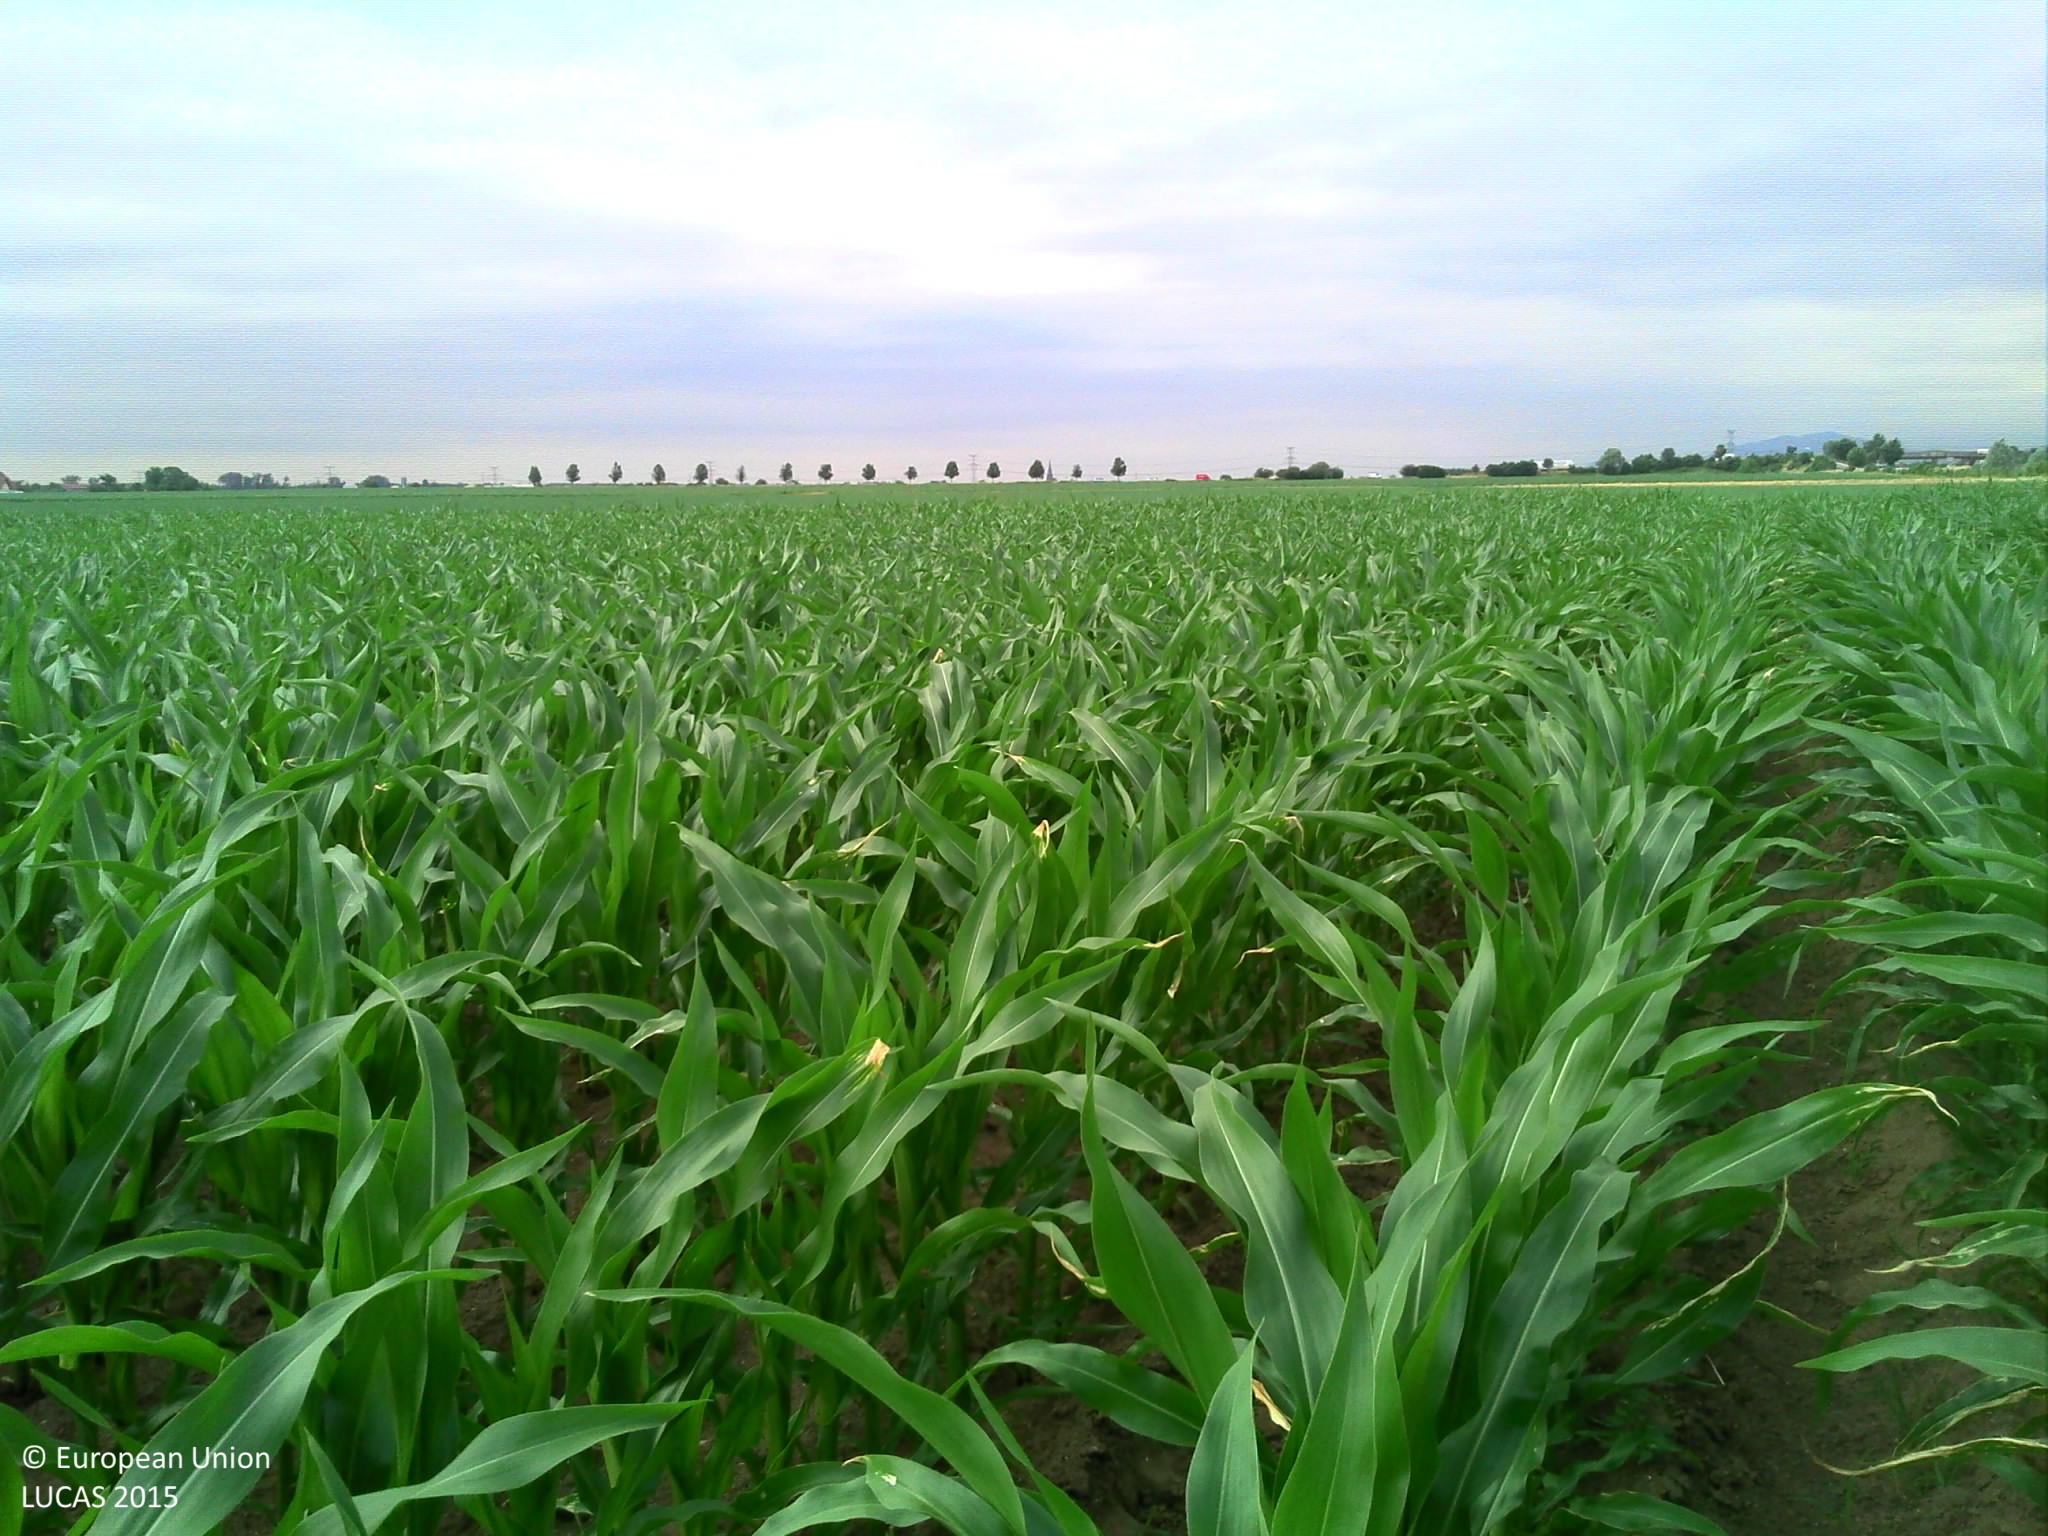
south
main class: Cropland
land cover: Maize
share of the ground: 25 - 50 %
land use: Agriculture (excluding fallow land and kitchen gardens)
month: June
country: FR
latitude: 48.4844
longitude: 7.5520
